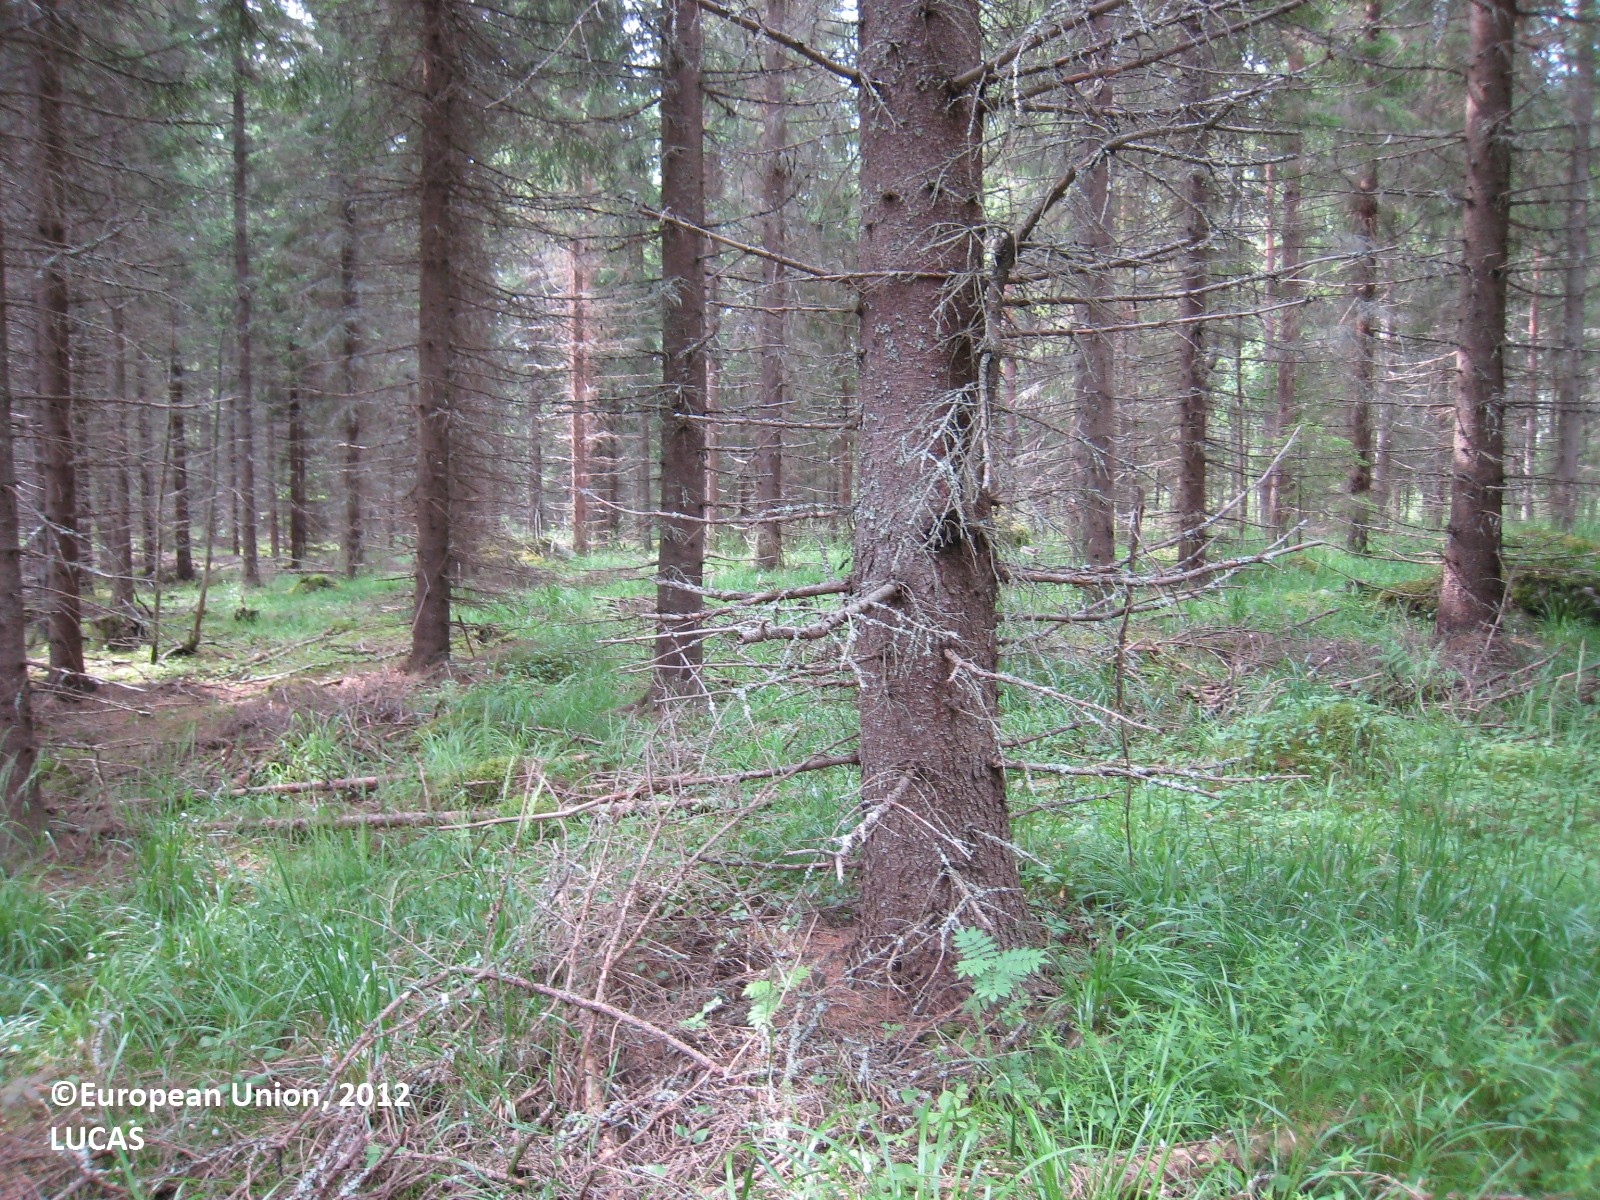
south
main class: Woodland
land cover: Spruce dominated coniferous woodland
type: boreal forest
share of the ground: 50 - 75 %
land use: Forestry
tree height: > 5 m
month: July
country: FI
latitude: 61.8721
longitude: 27.1815
